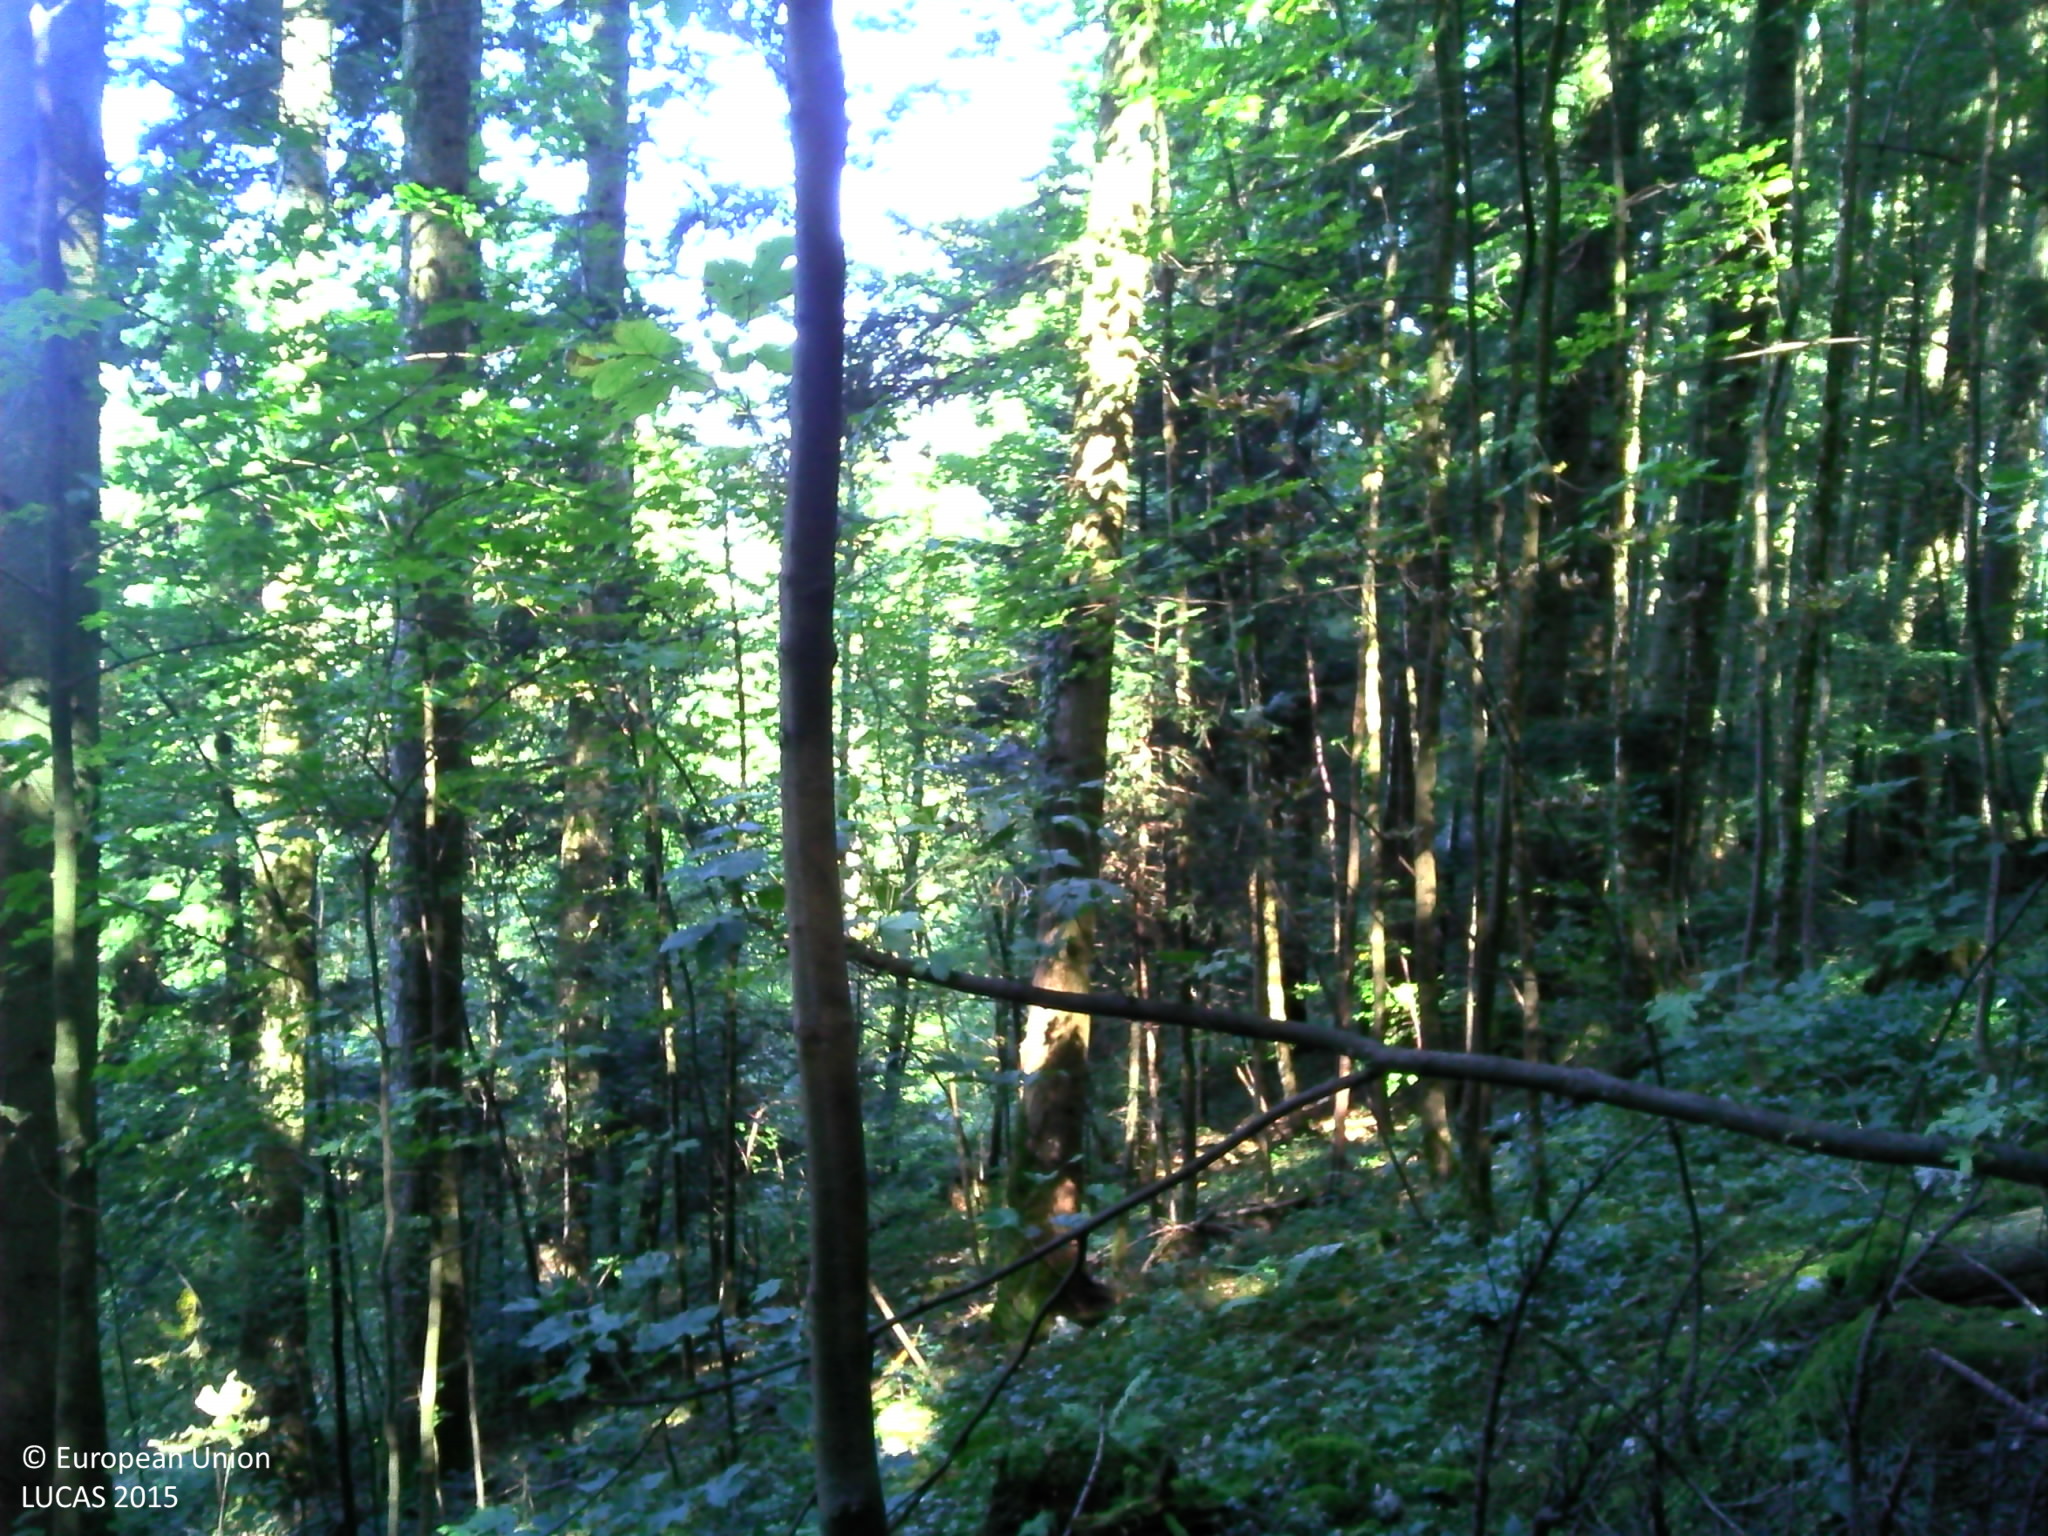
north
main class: Woodland
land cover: Spruce dominated mixed woodland
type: mountainous beech forest
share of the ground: > 75 %
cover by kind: coniferous forest trees 55 %, broadleaved forest trees 35 %, shrubs 5 %, lichens and mosses 5 %
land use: Forestry
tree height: > 5 m
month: September
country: FR
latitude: 47.1995
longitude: 6.6360
